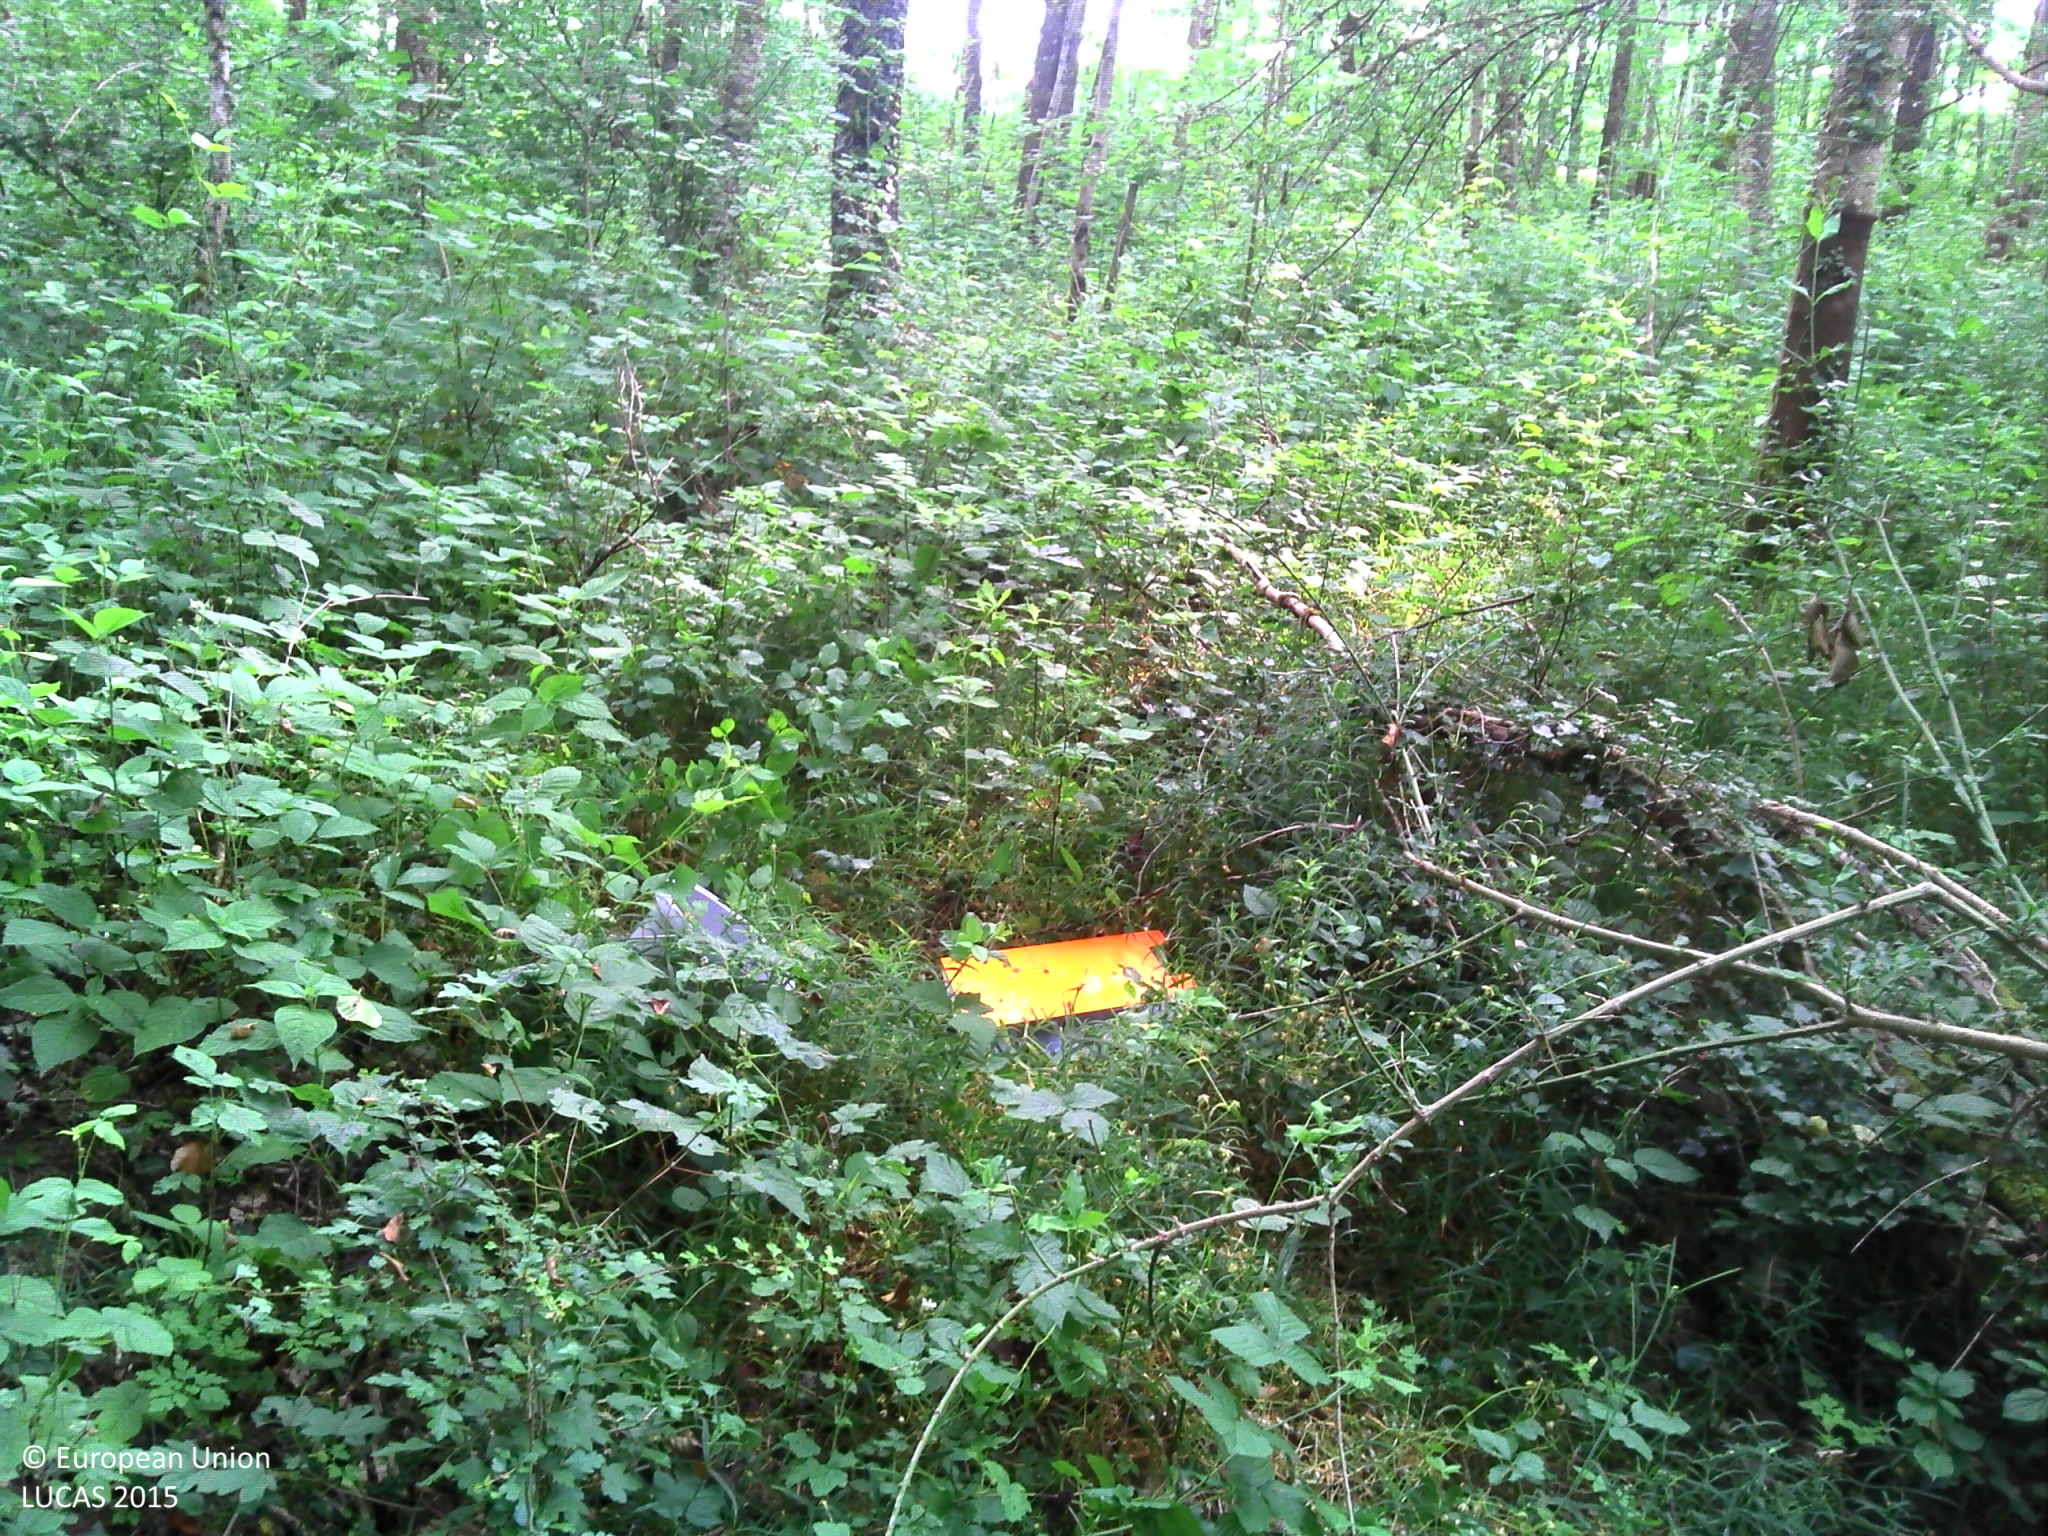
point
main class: Woodland
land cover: Broadleaved woodland
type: beech forest
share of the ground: > 75 %
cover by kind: broadleaved forest trees 90 %, herbaceous plants 10 %
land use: Forestry
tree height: > 5 m
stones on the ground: < 10 %
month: June
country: FR
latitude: 47.7114
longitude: 6.3092
